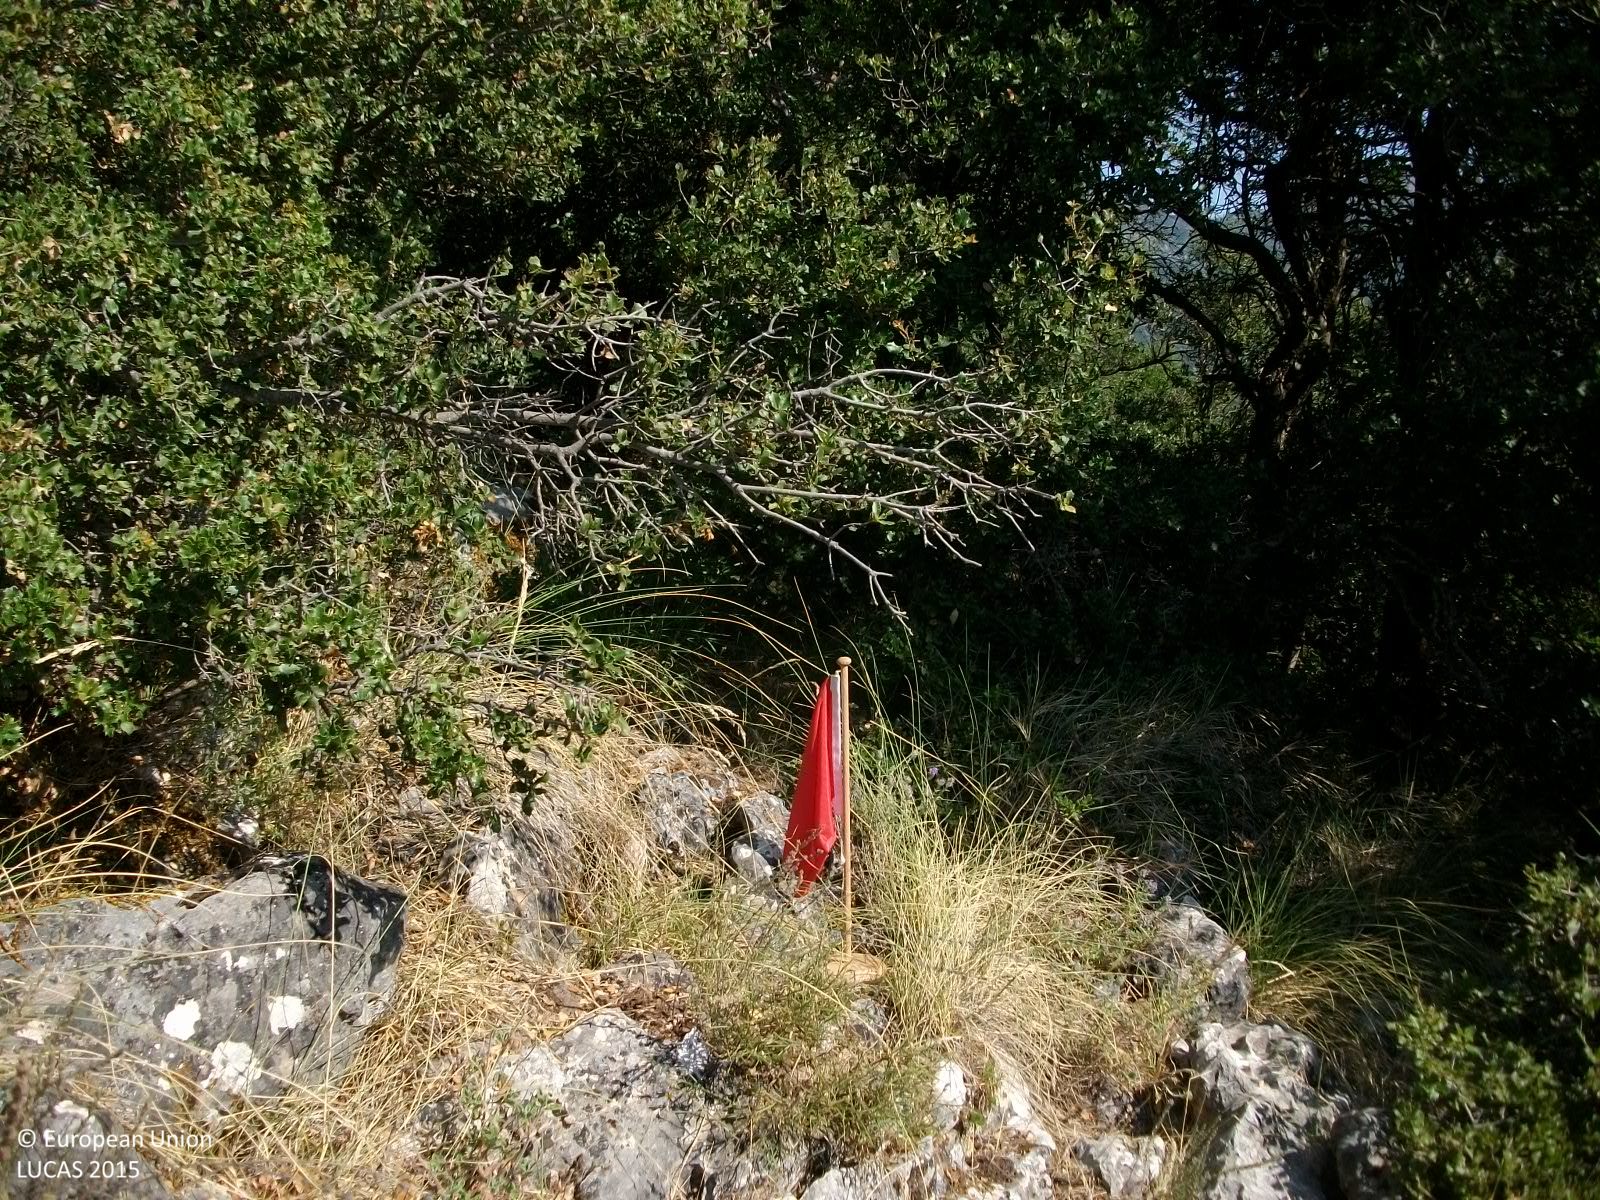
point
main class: Shrubland
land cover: Shrubland with sparse tree cover
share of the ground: > 75 %
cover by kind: shrubs 75 %, unconsolidated bare surface 15 %, broadleaved forest trees 5 %, herbaceous plants 5 %
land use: Agriculture (excluding fallow land and kitchen gardens)
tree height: < 5 m
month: July
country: GR
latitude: 36.9320
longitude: 22.4045
